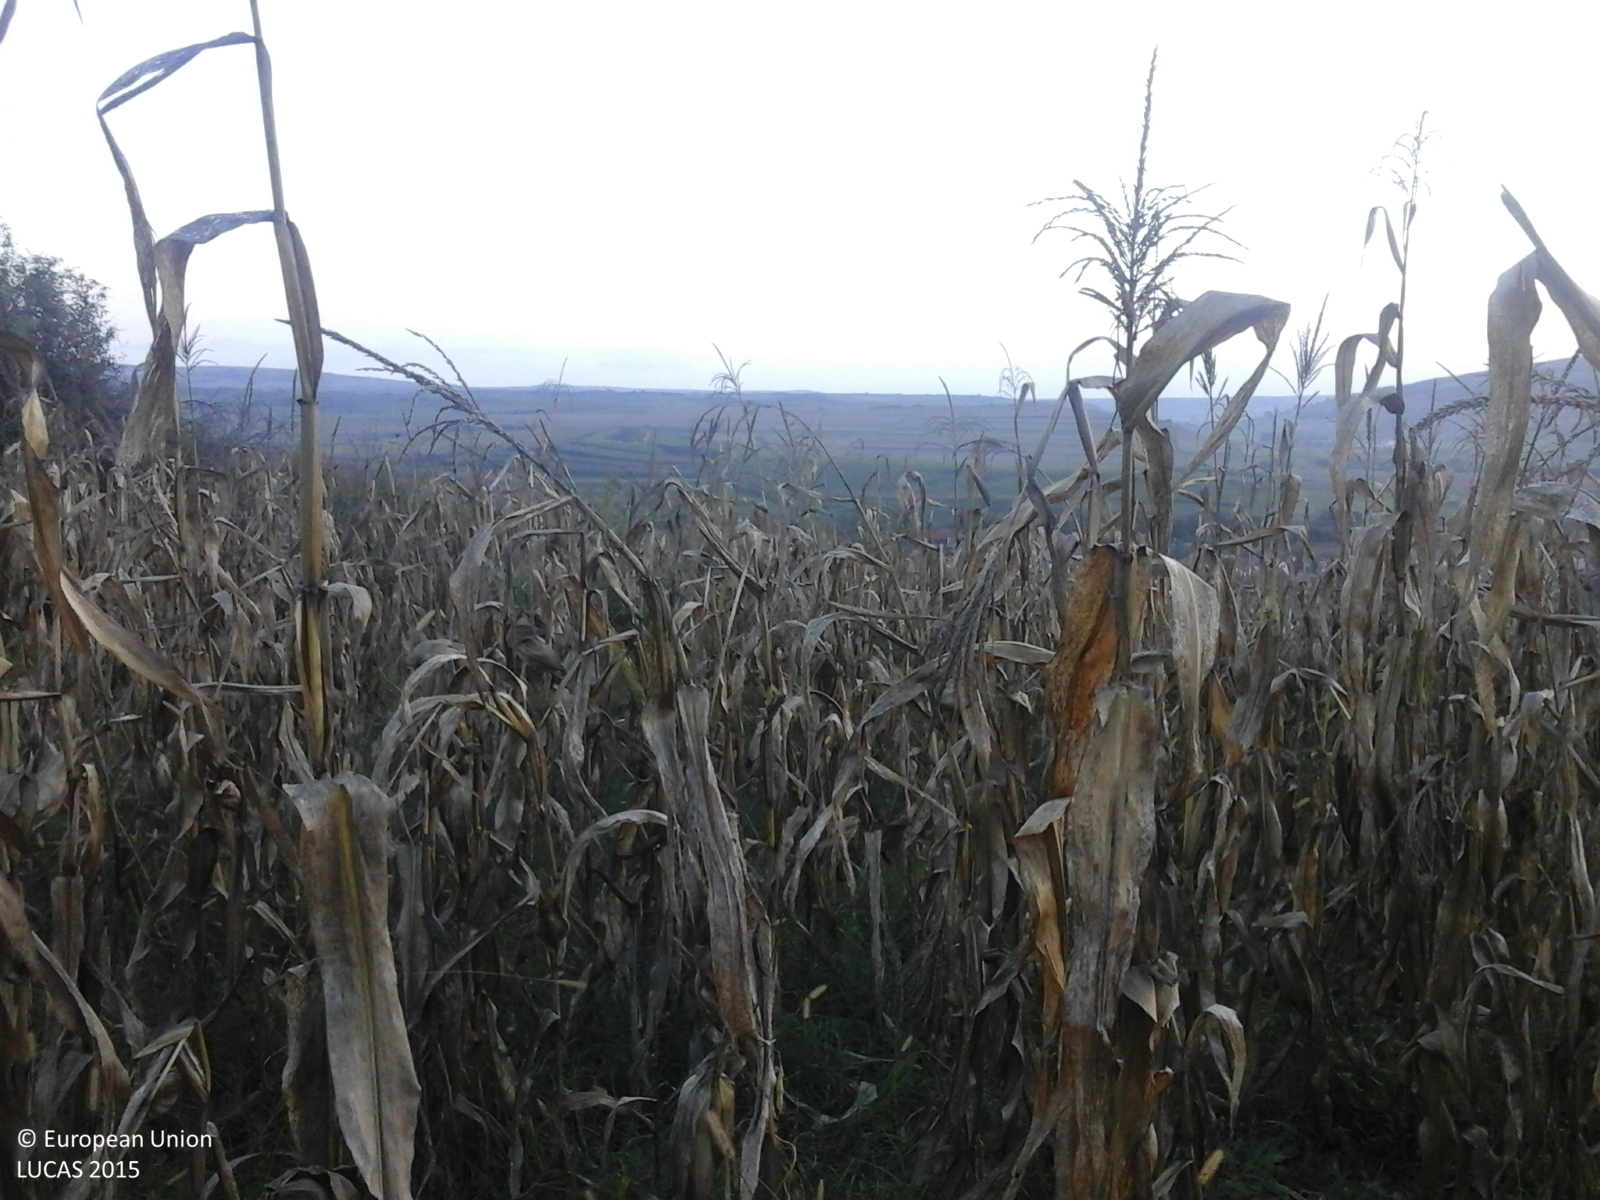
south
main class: Cropland
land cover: Maize
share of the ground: > 75 %
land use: Agriculture (excluding fallow land and kitchen gardens)
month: October
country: RO
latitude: 46.0234
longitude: 24.1703
